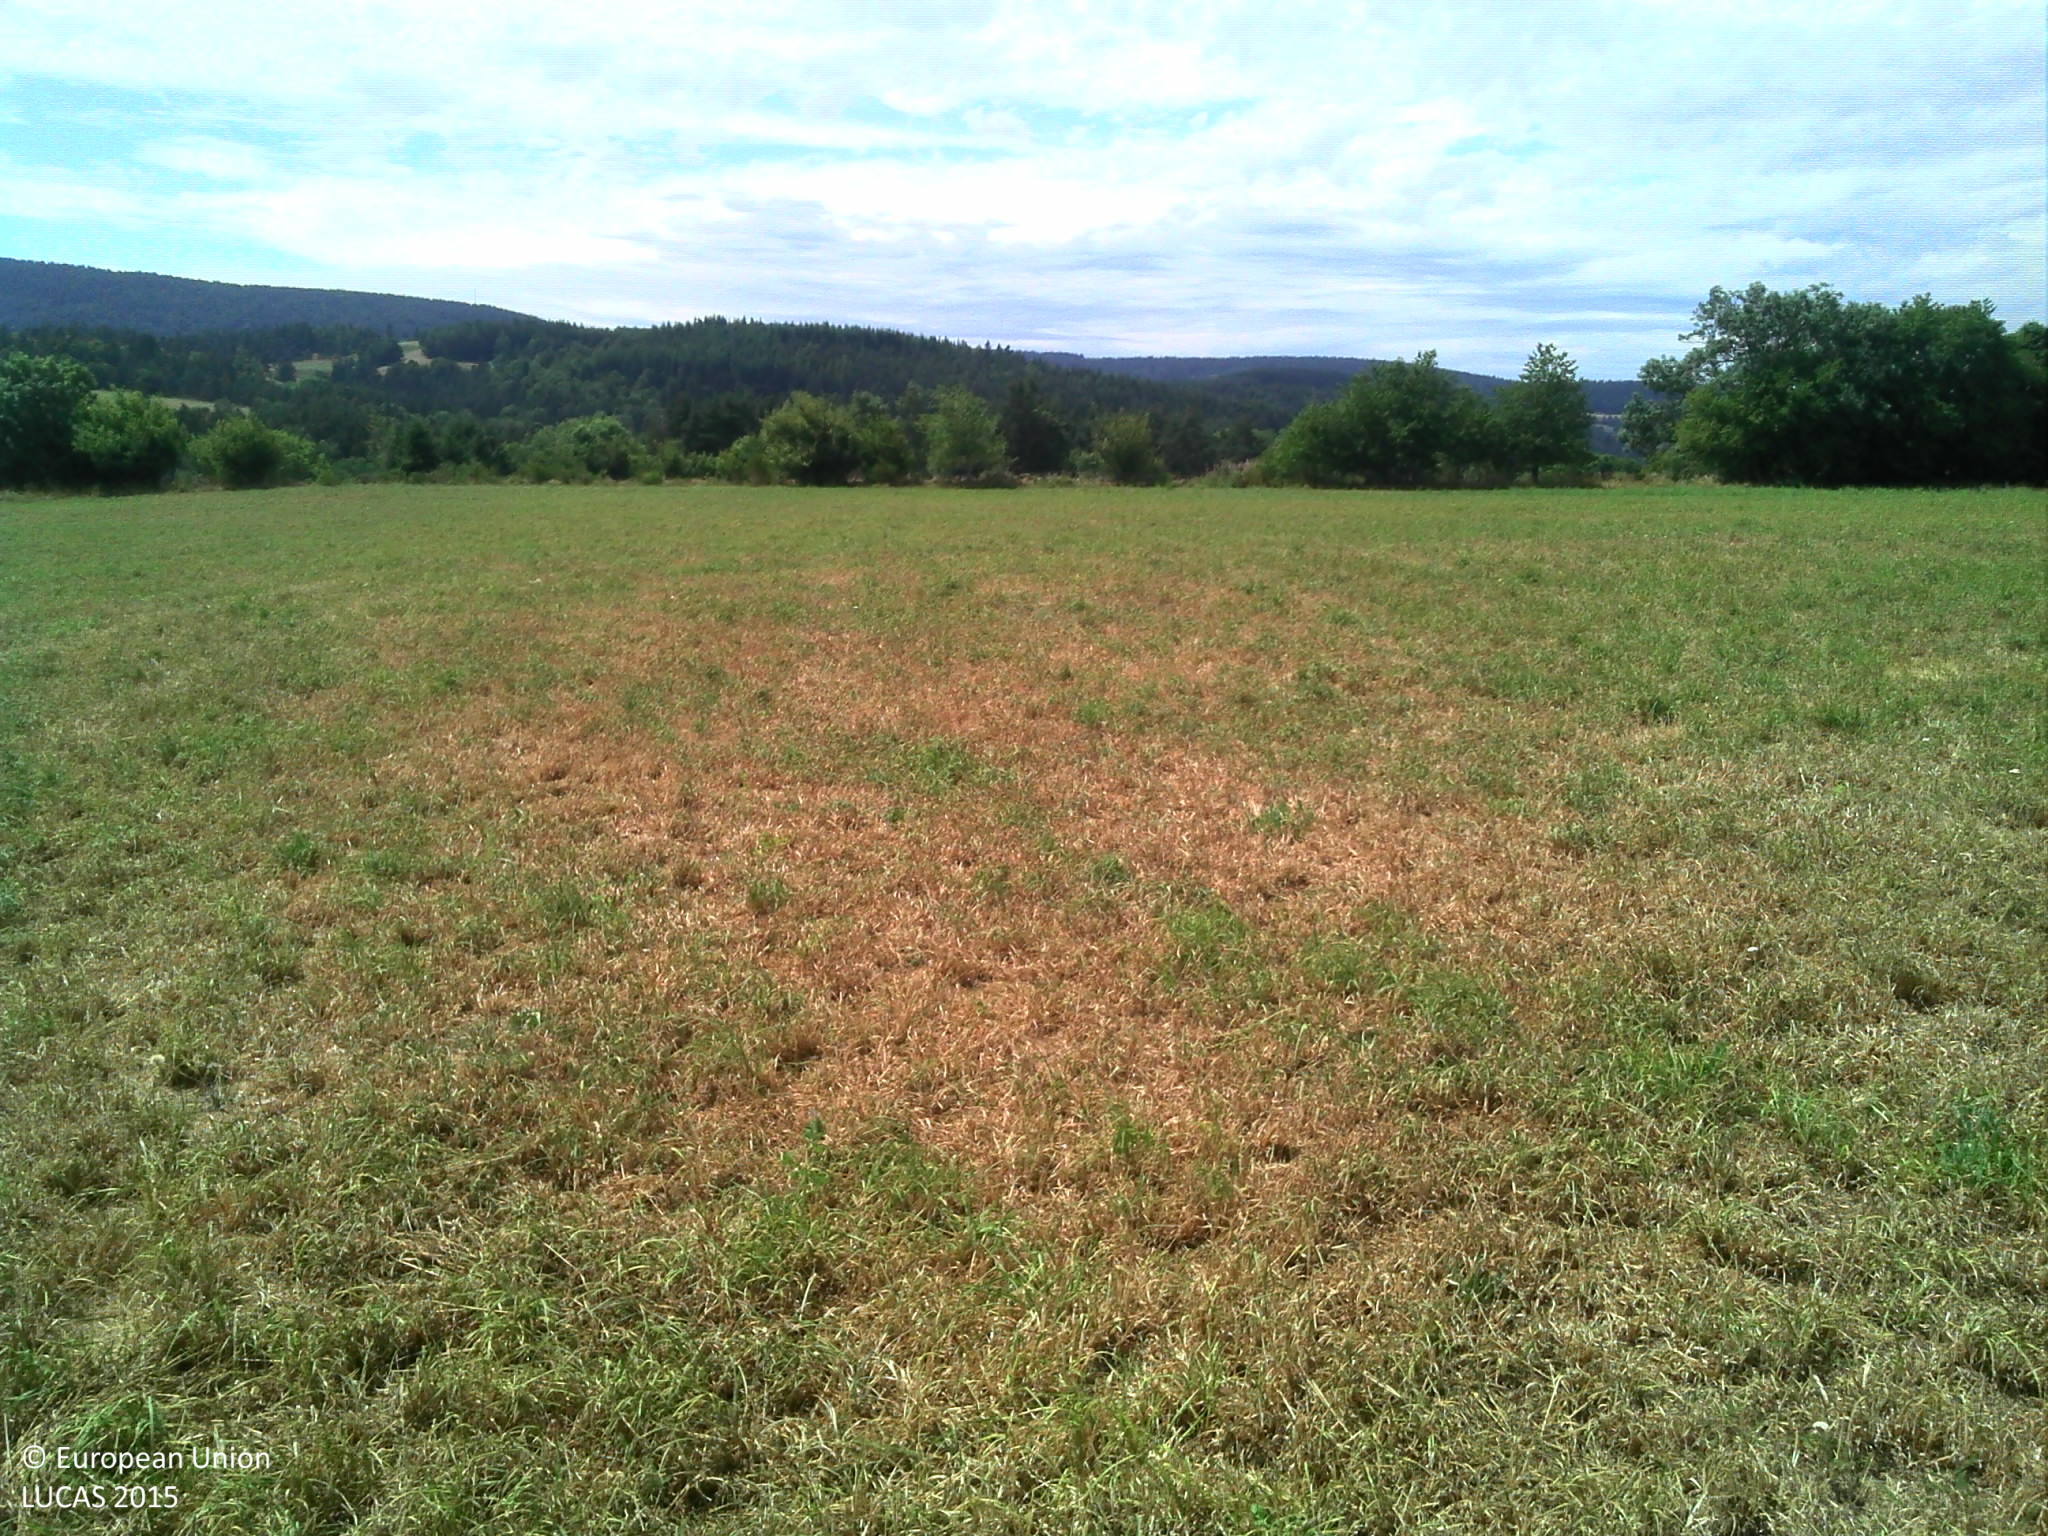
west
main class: Grassland
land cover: Grassland without tree/shrub cover
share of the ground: > 75 %
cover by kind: herbaceous plants 100 %
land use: Agriculture (excluding fallow land and kitchen gardens)
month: July
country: FR
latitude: 44.6780
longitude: 3.9121
